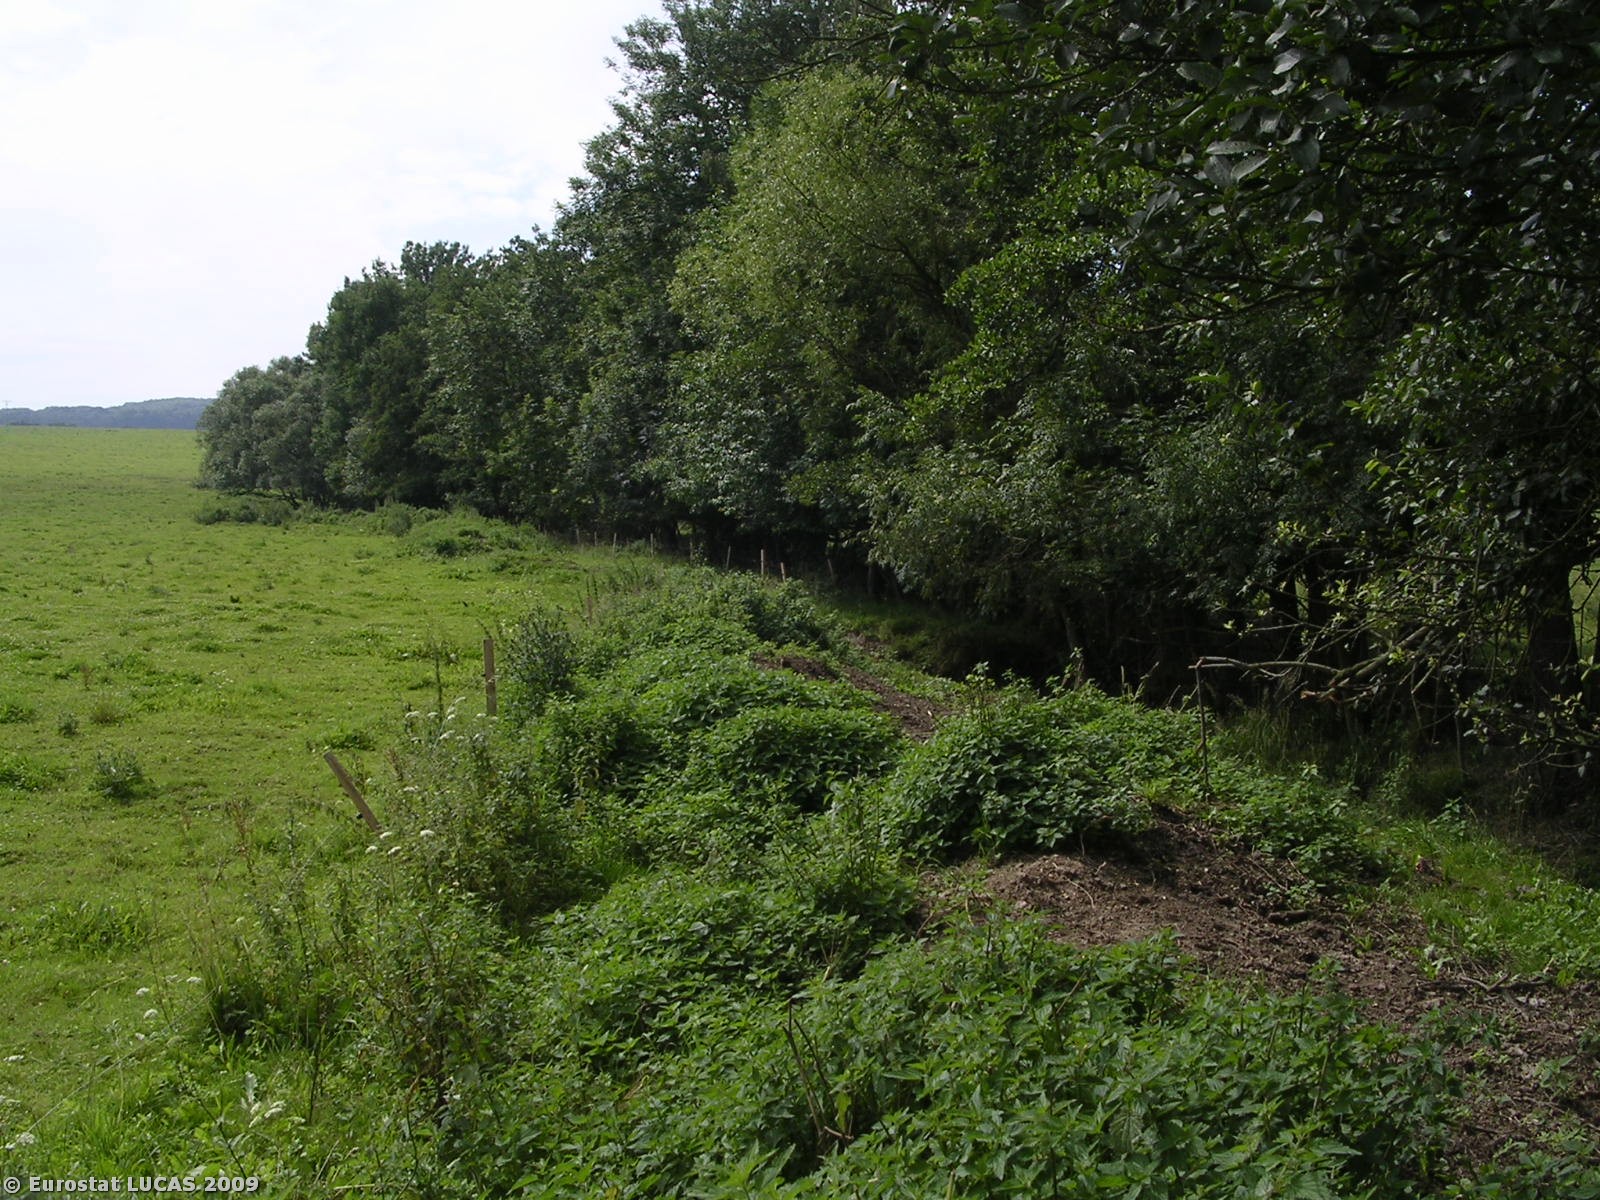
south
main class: Grassland
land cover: Spontaneously vegetated surfaces
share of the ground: > 75 %
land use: Unused
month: July
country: CZ
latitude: 50.6913
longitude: 14.4608
